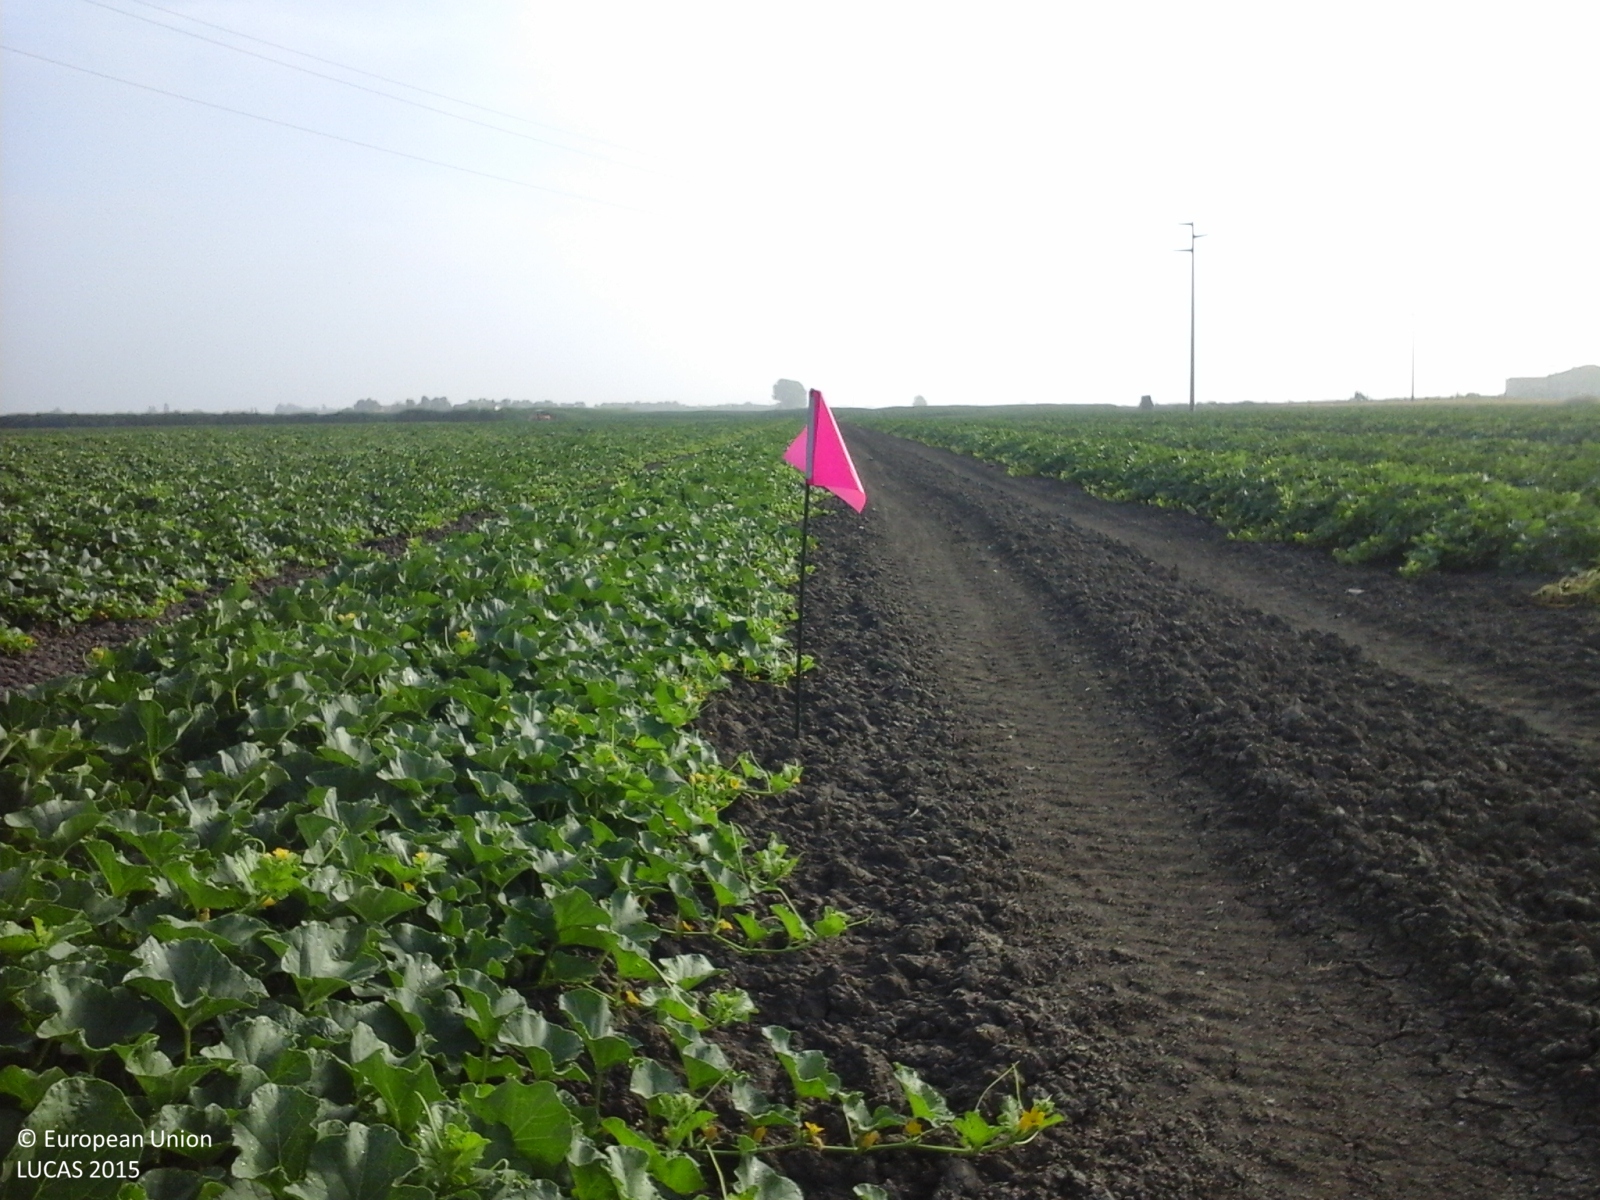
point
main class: Cropland
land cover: Other fresh vegetables
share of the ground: 50 - 75 %
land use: Agriculture (excluding fallow land and kitchen gardens)
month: June
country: IT
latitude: 44.9396
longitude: 11.1257
